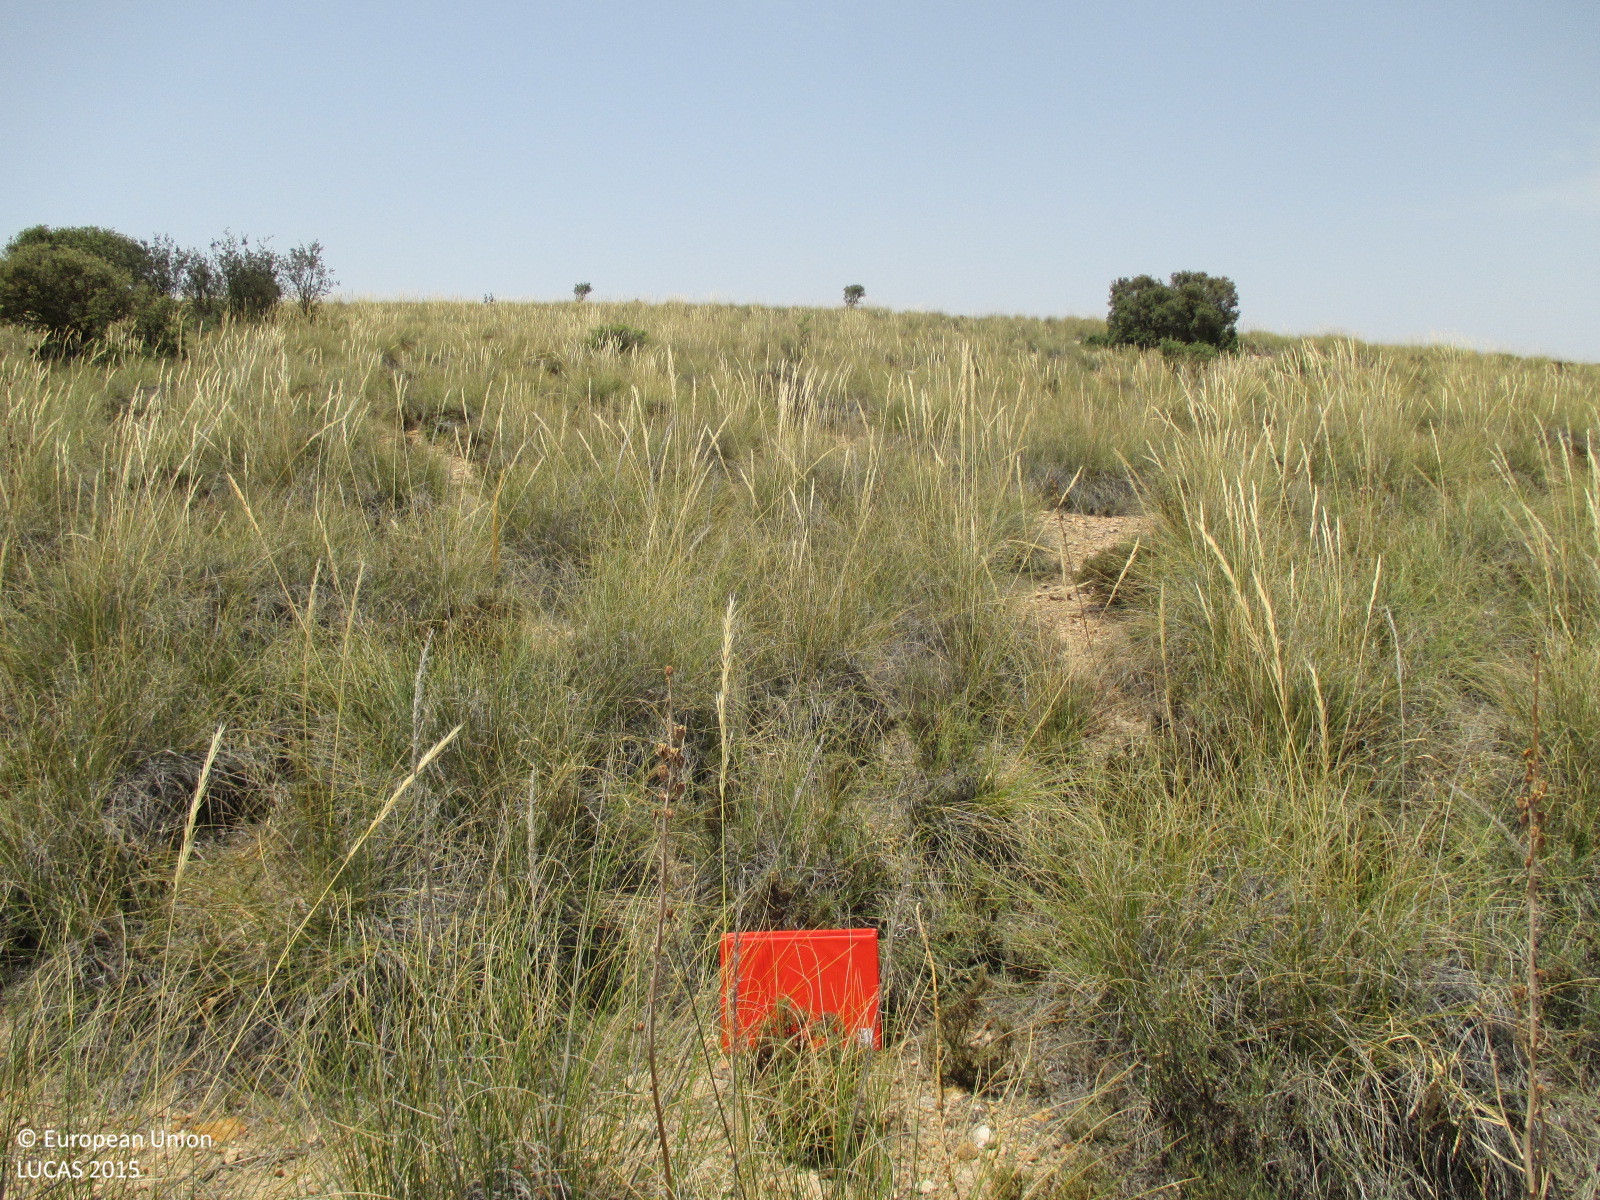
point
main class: Grassland
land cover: Grassland without tree/shrub cover
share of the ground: > 75 %
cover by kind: herbaceous plants 95 %, consolidated bare surface 5 %
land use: Semi-natural and natural areas not in use
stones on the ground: < 10 %
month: July
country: ES
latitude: 37.8619
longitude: -2.2990
